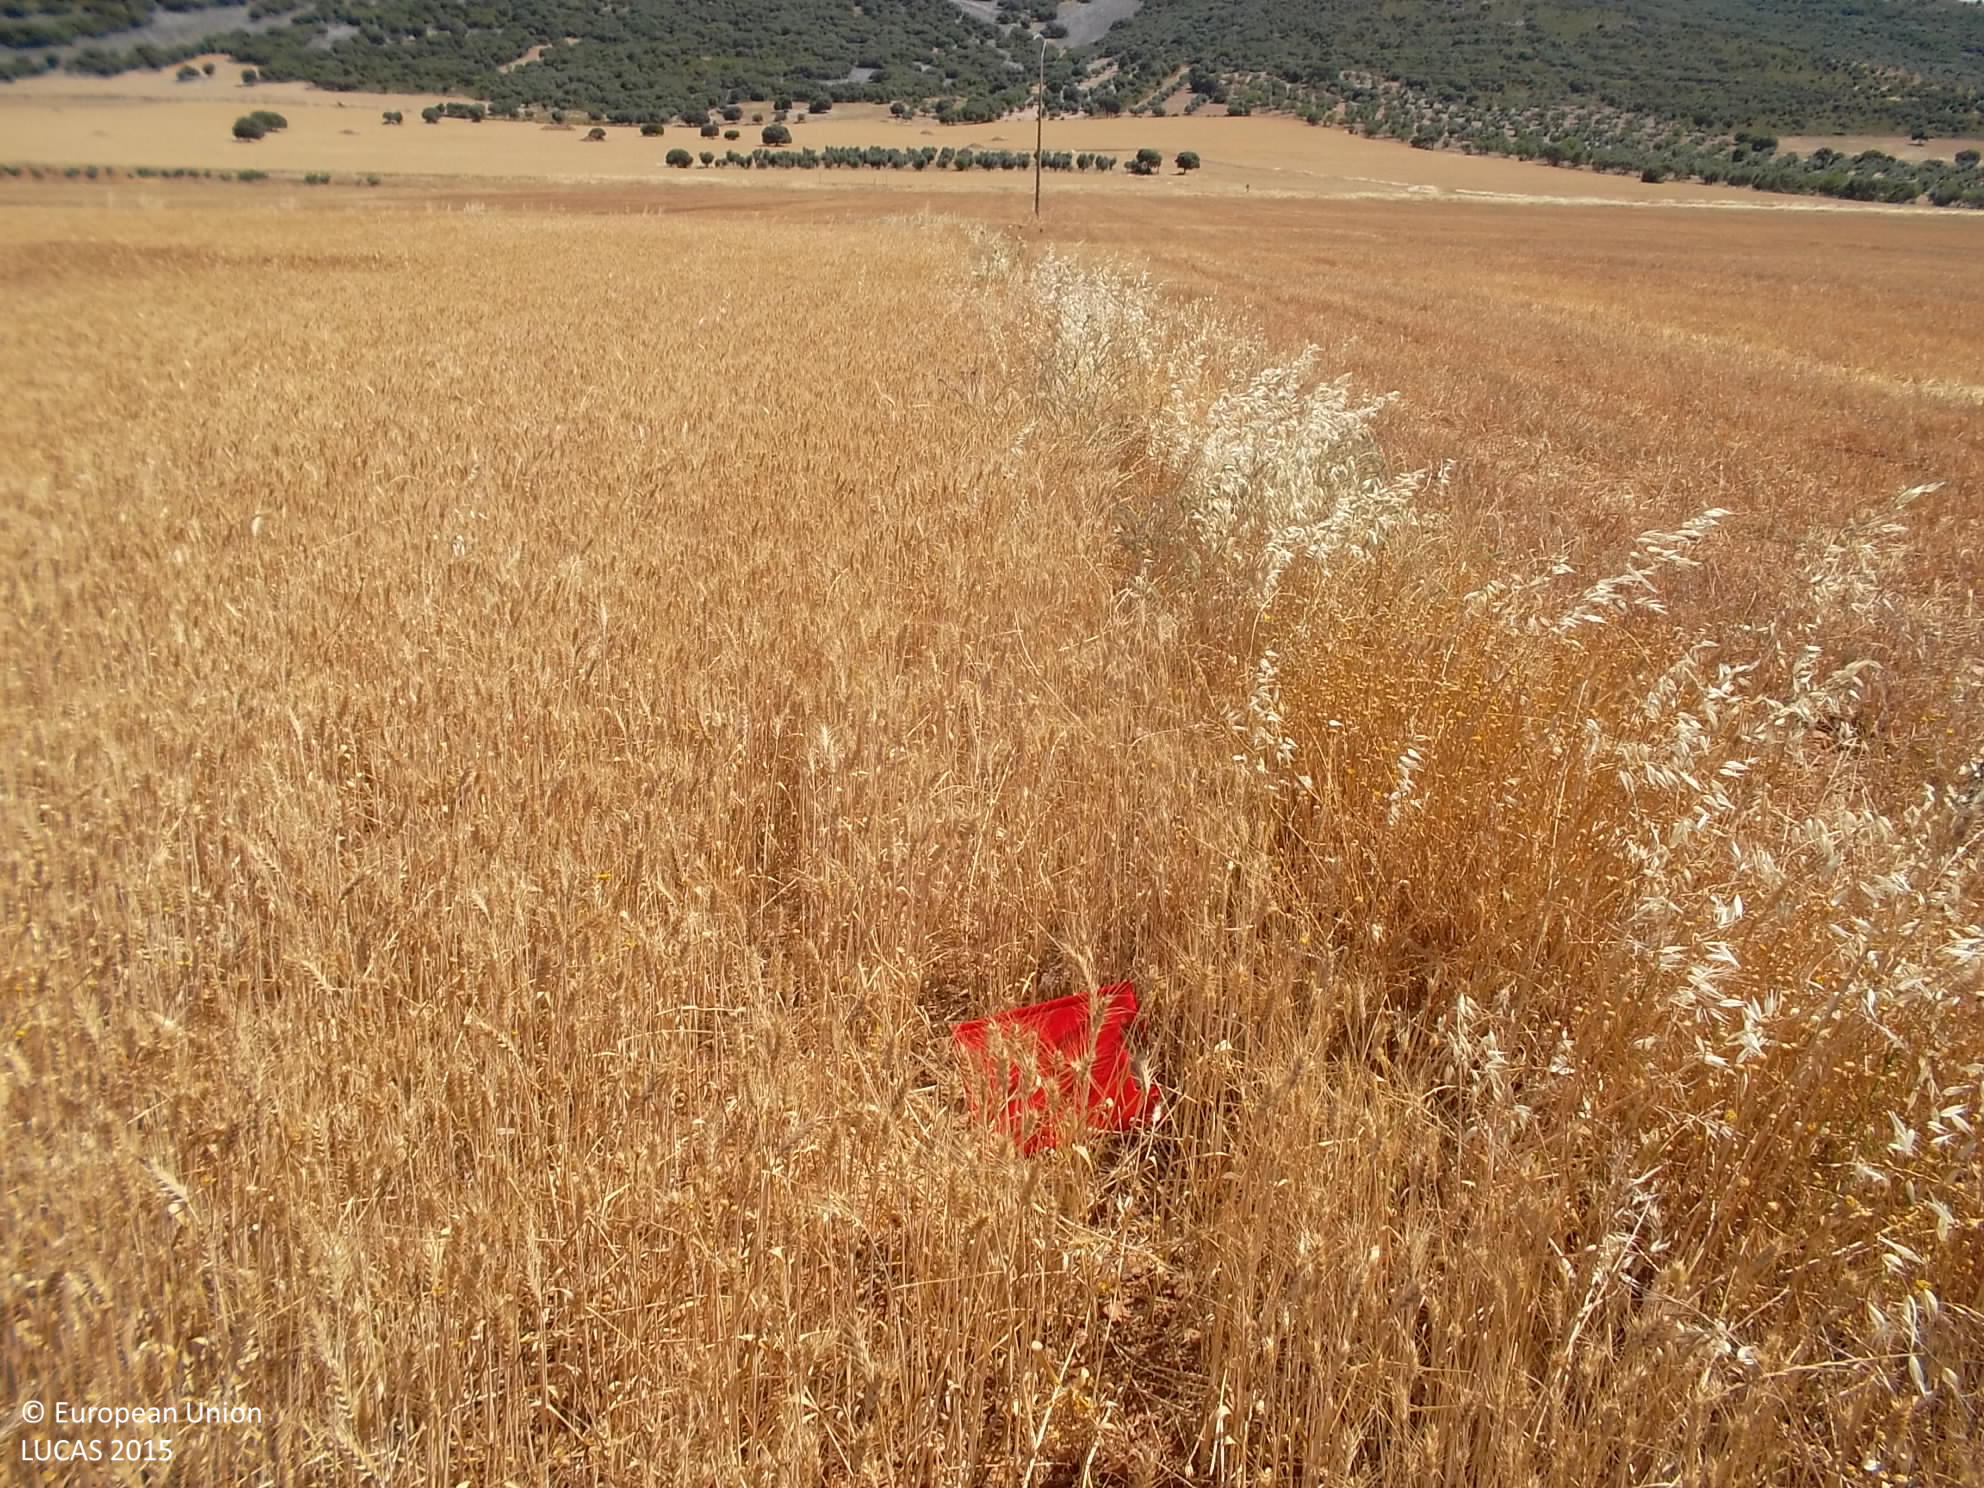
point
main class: Cropland
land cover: Common wheat
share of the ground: 50 - 75 %
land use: Agriculture (excluding fallow land and kitchen gardens)
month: June
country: ES
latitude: 39.1506
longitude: -4.1075
